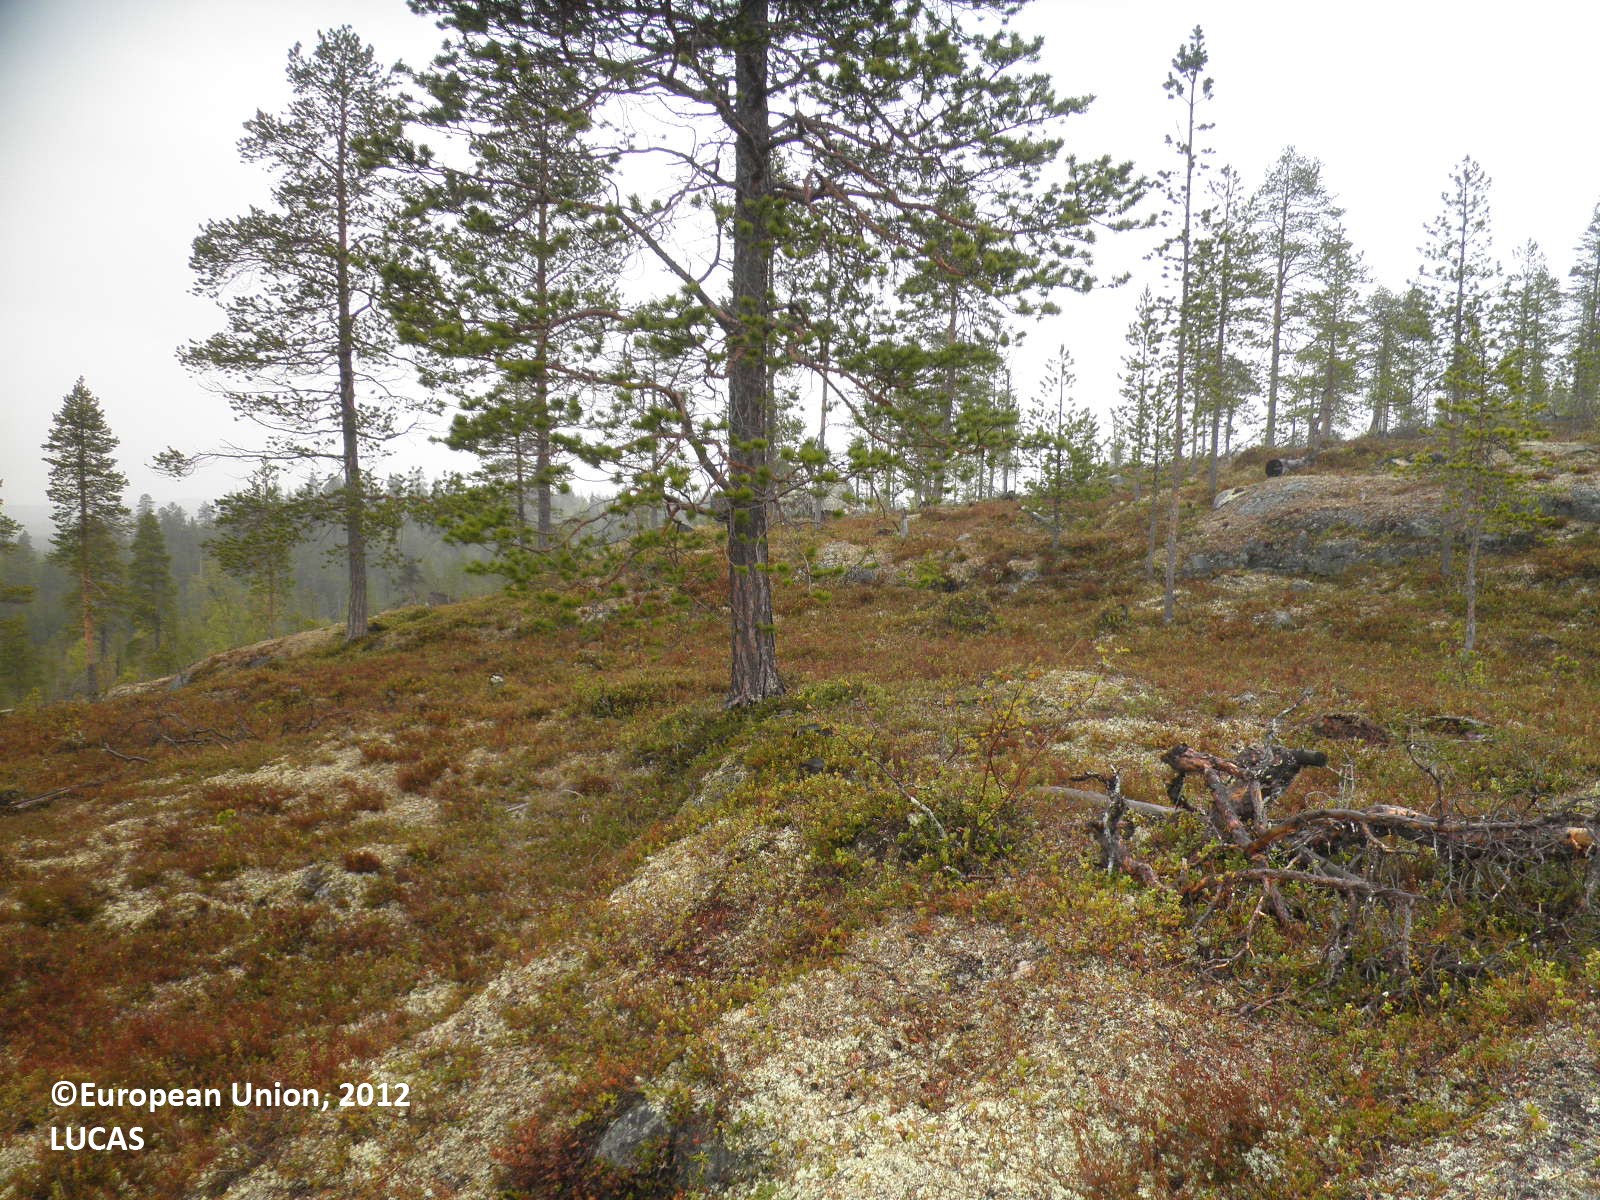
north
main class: Woodland
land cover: Pine dominated coniferous woodland
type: boreal forest
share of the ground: 10 - 25 %
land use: Forestry
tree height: > 5 m
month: June
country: FI
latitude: 69.0809
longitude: 27.2018
